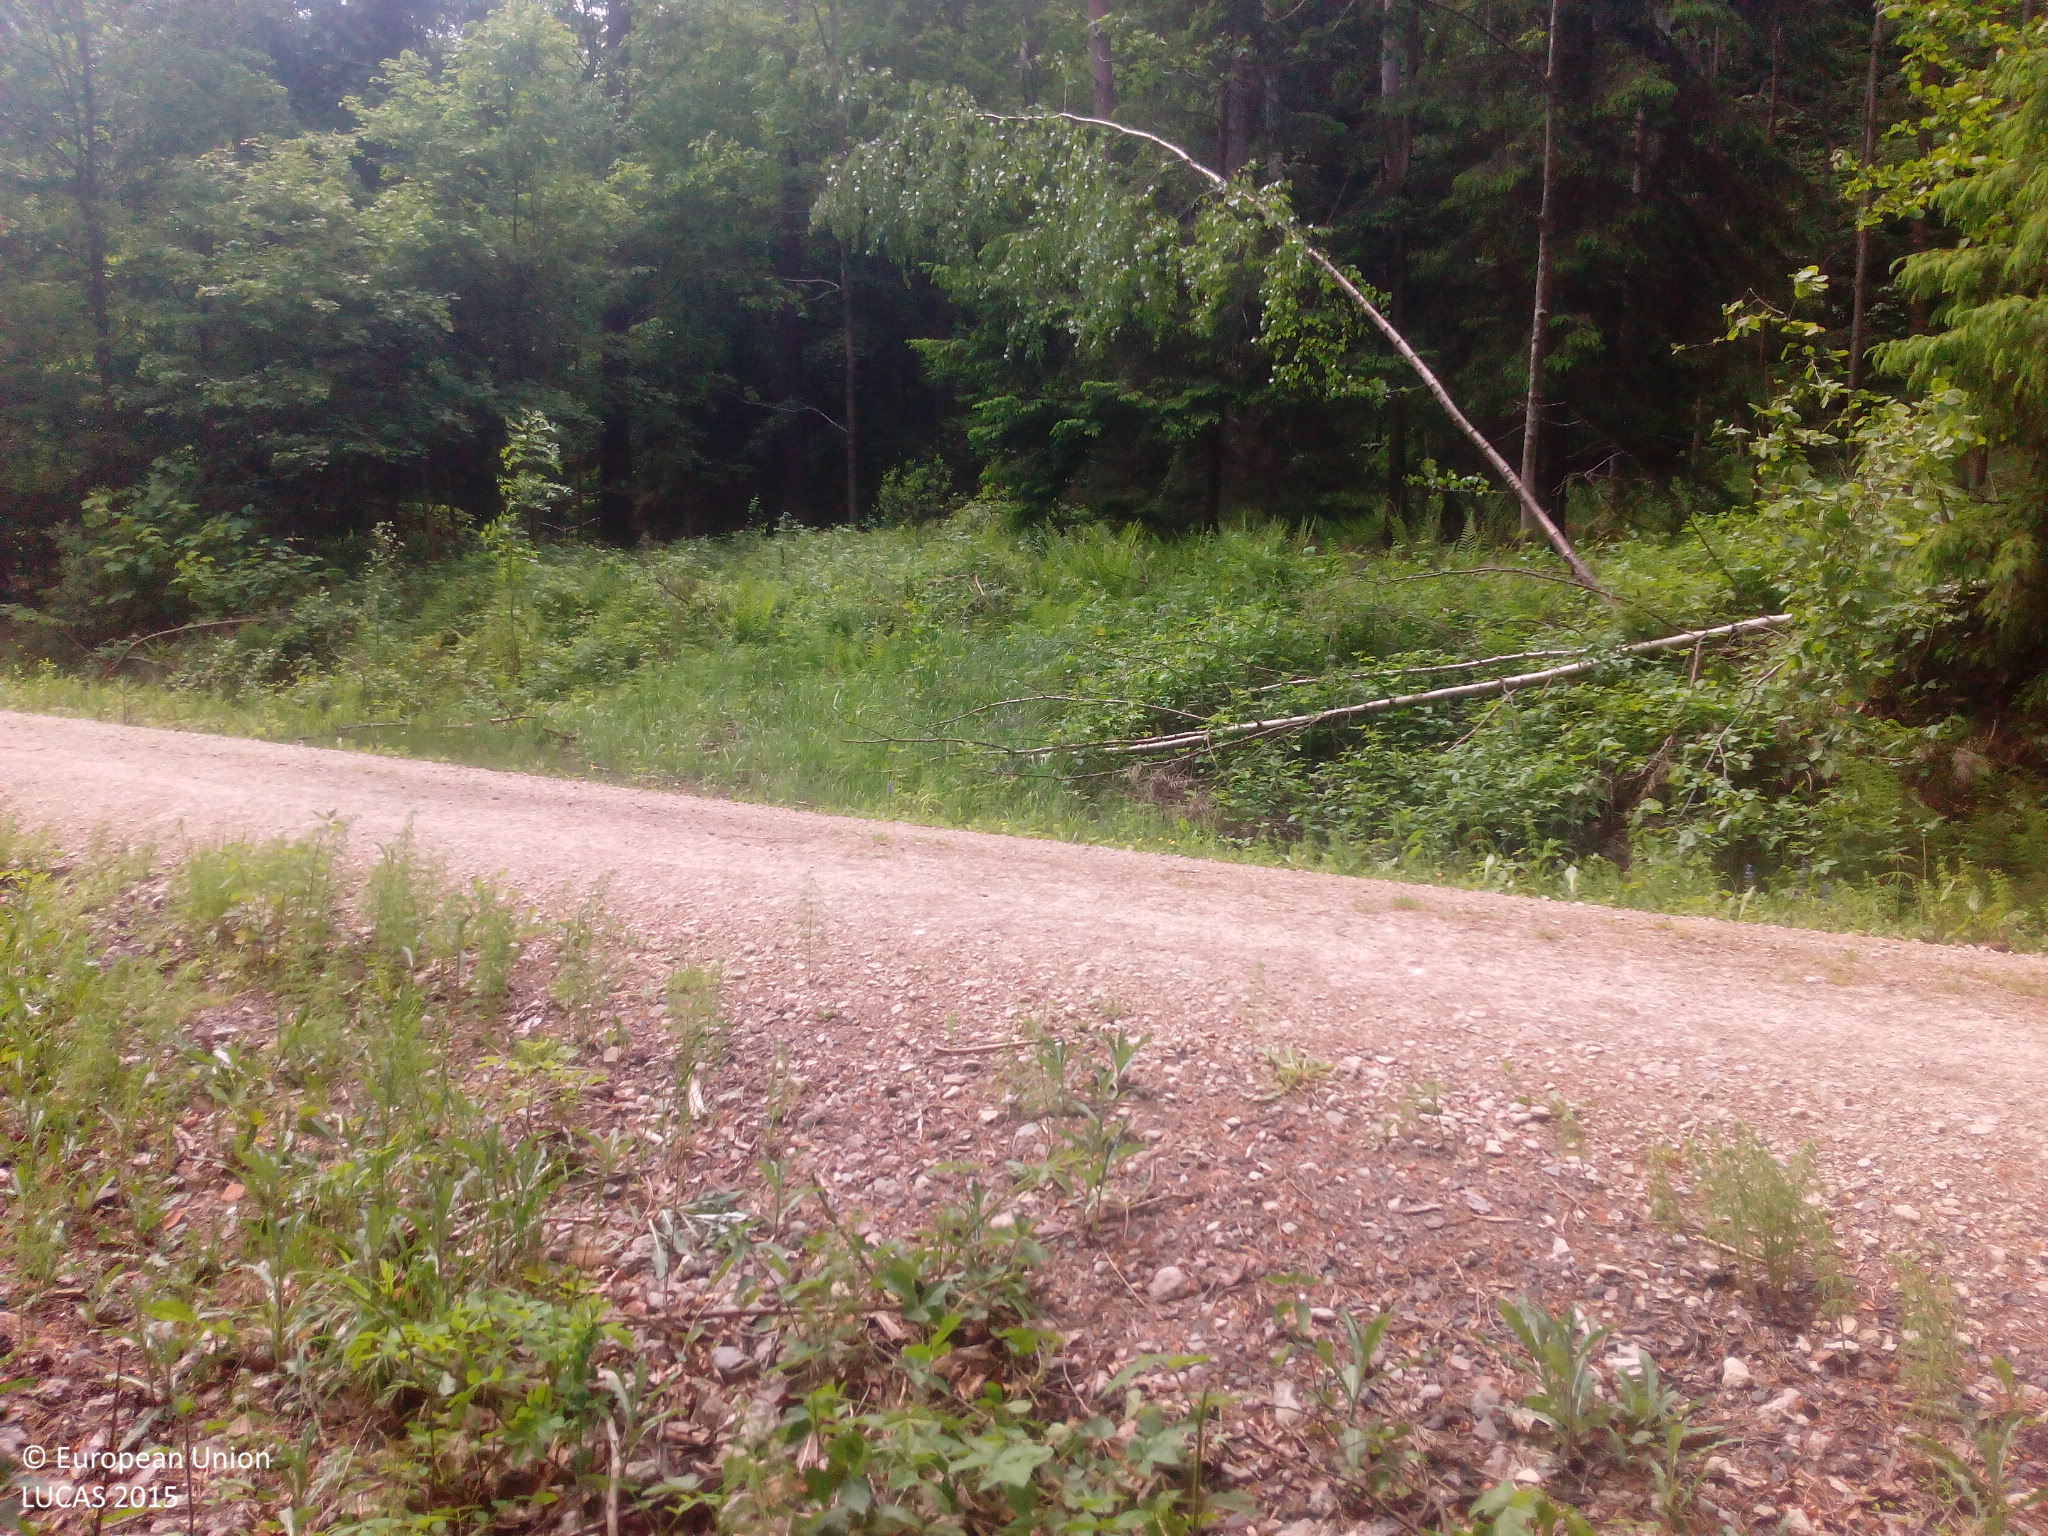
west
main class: Woodland
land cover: Spruce dominated mixed woodland
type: hemiboreal forest and nemoral coniferous forest and mixed broadleaved-coniferous forest
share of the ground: > 75 %
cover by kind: broadleaved forest trees 70 %, coniferous forest trees 30 %
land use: Forestry
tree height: > 5 m
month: May
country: DE
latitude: 50.2163
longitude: 10.9387
